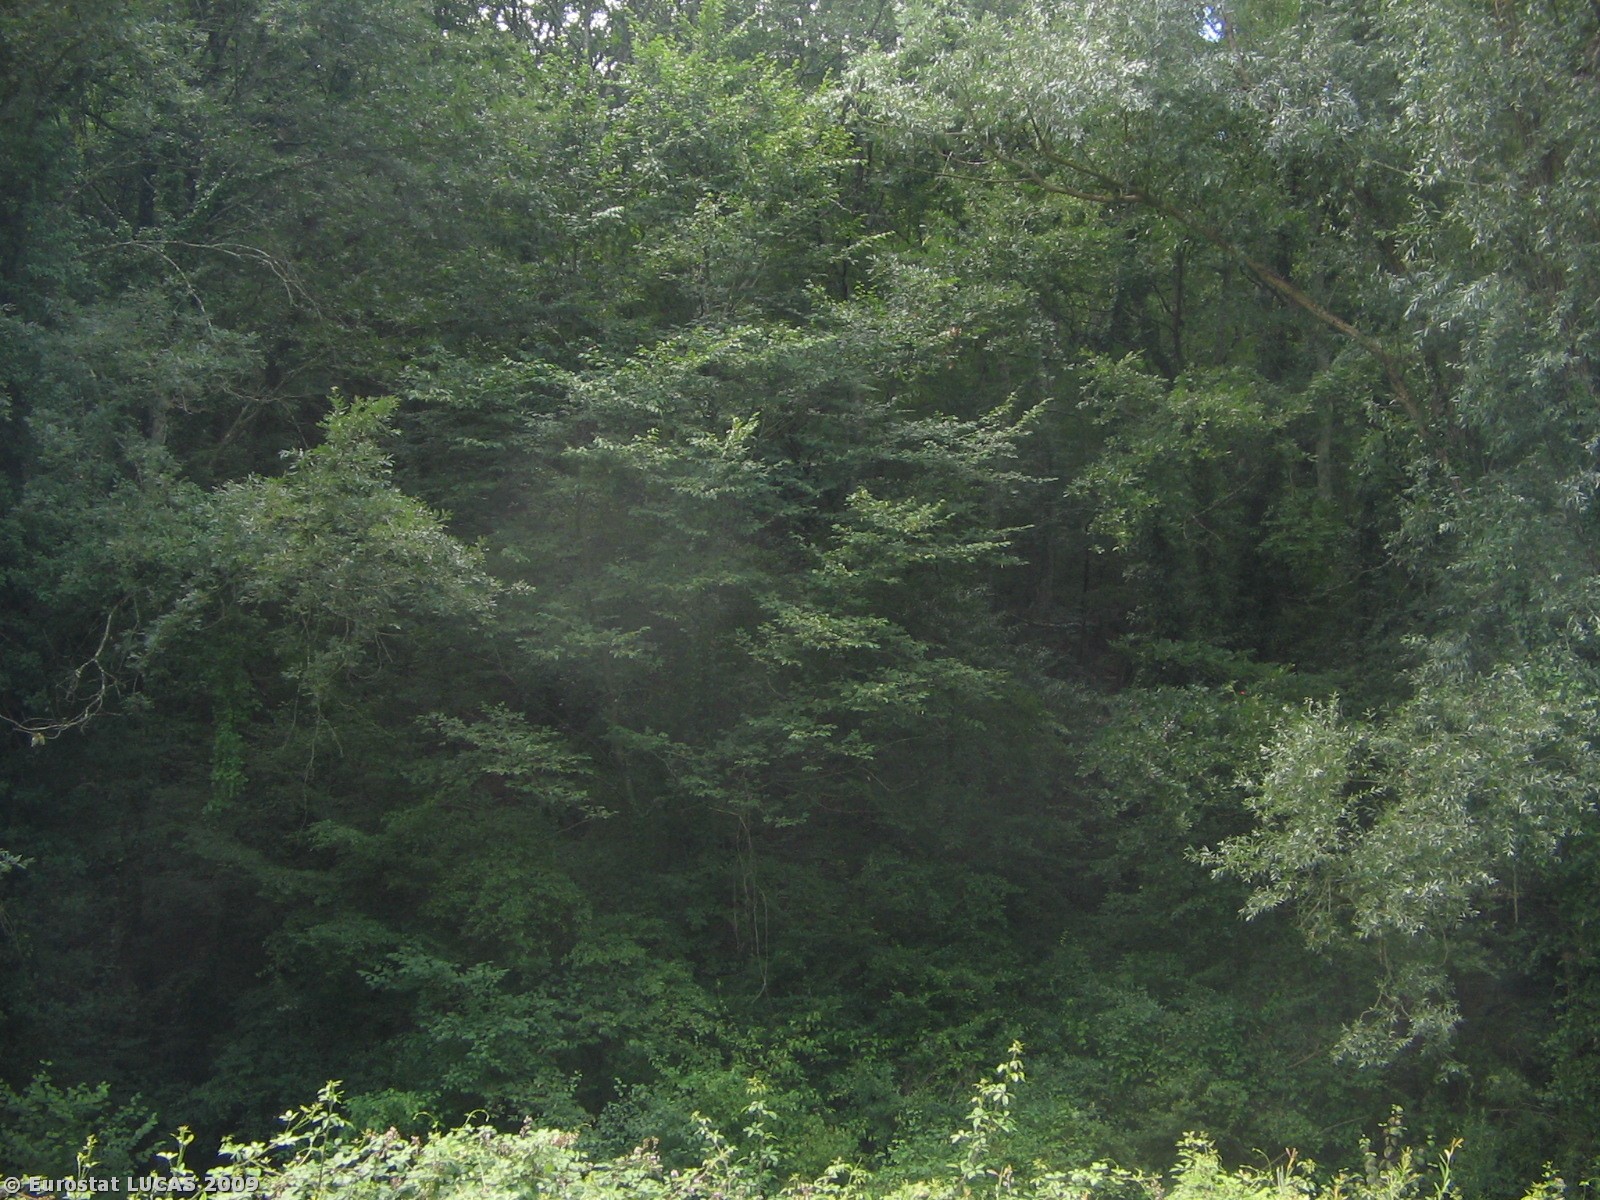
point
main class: Woodland
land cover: Broadleaved woodland
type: thermophilous deciduous forest
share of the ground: > 75 %
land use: Forestry
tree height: > 5 m
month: July
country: IT
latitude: 42.2160
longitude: 12.8612
